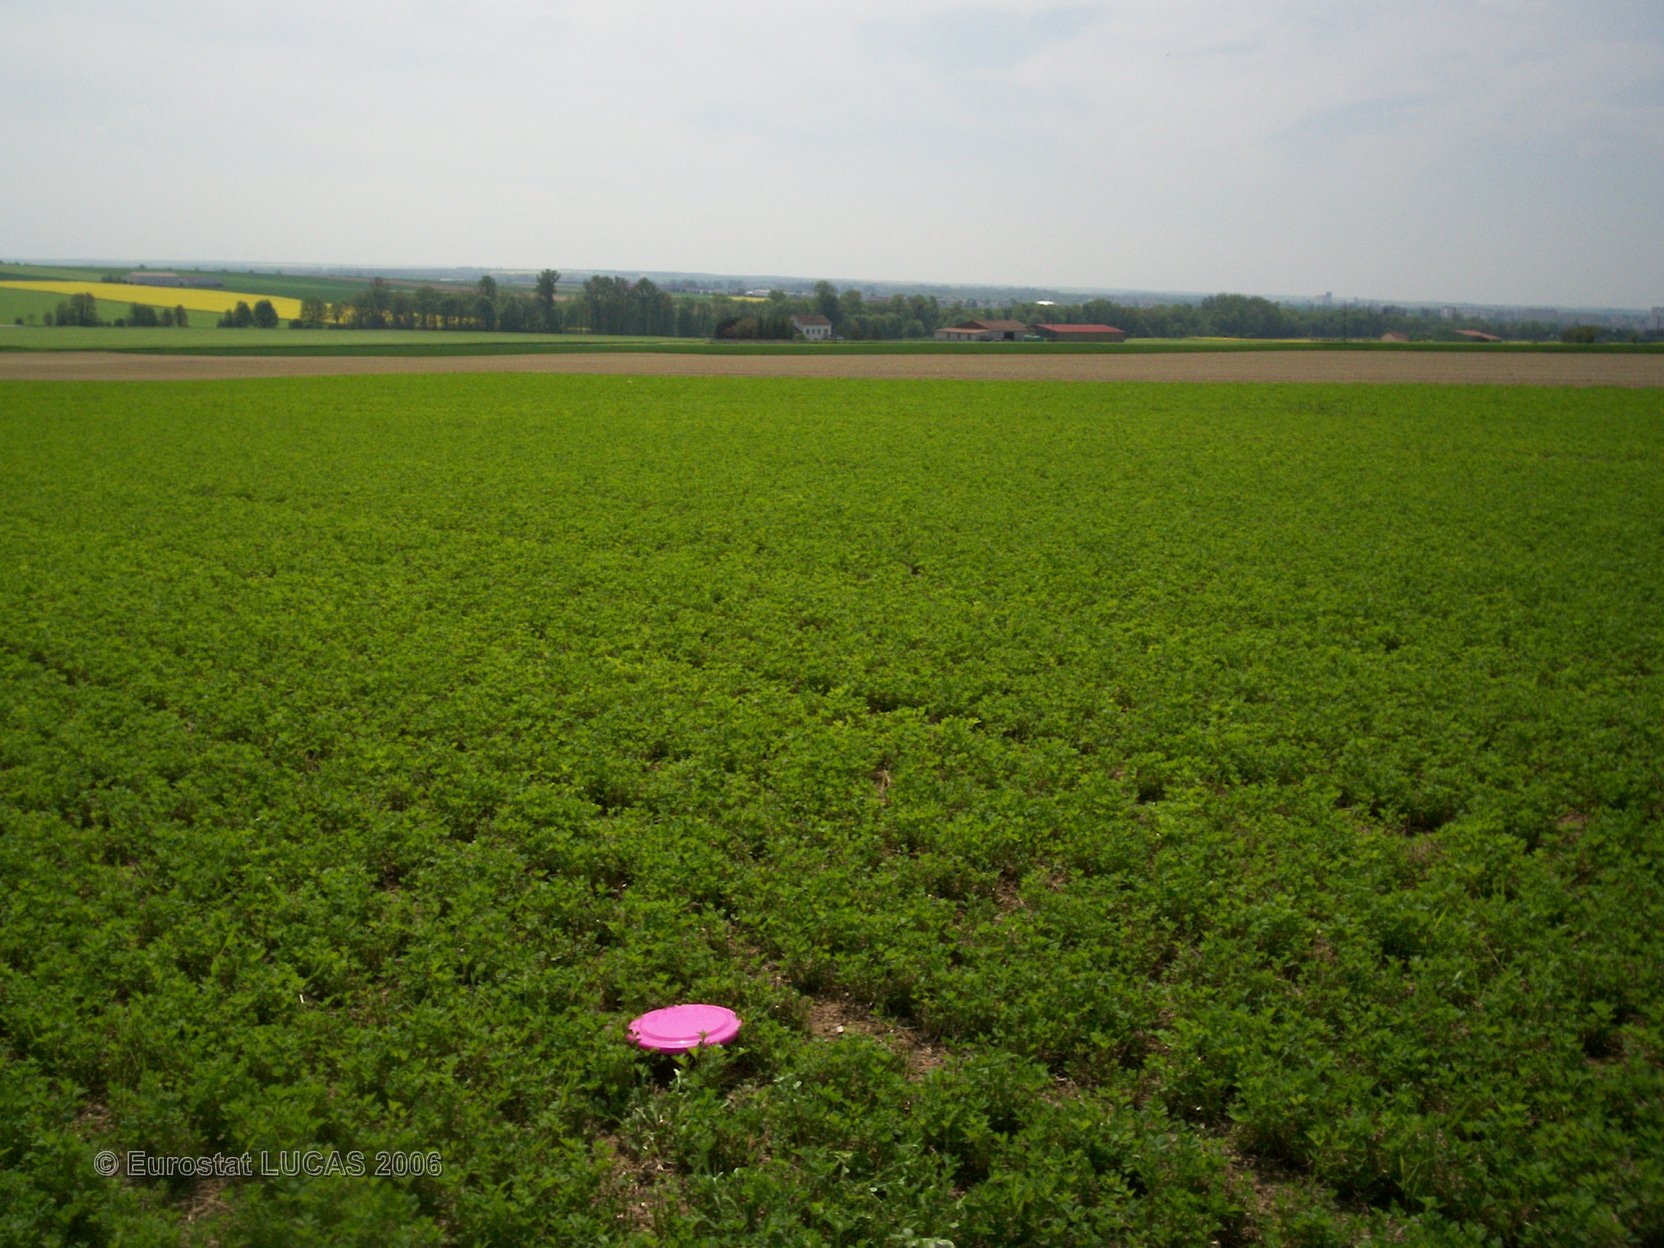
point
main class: Cropland
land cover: Lucerne
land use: Agriculture (excluding fallow land and kitchen gardens)
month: May
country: FR
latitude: 48.9654
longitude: 4.4098
